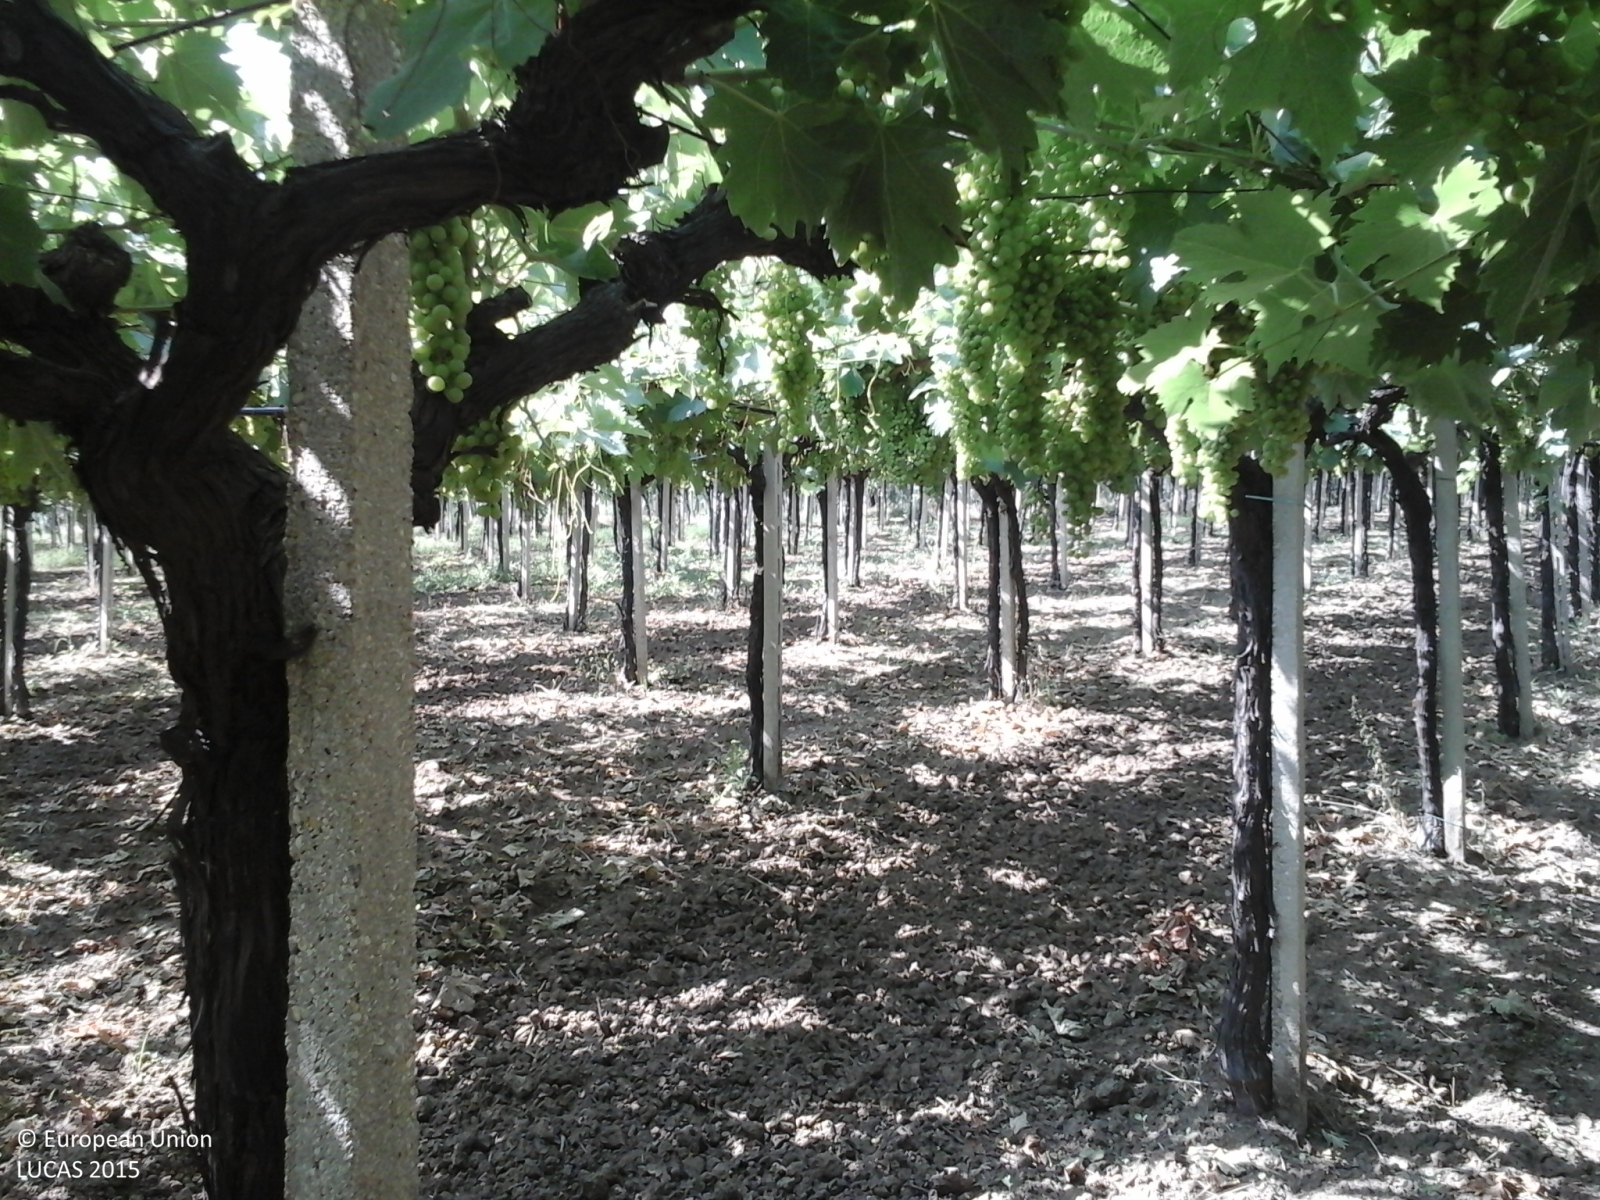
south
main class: Cropland
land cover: Vineyards
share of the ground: 25 - 50 %
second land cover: Spontaneously vegetated surfaces
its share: 25 - 50 %
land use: Agriculture (excluding fallow land and kitchen gardens)
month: July
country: IT
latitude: 42.3629
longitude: 14.3218
